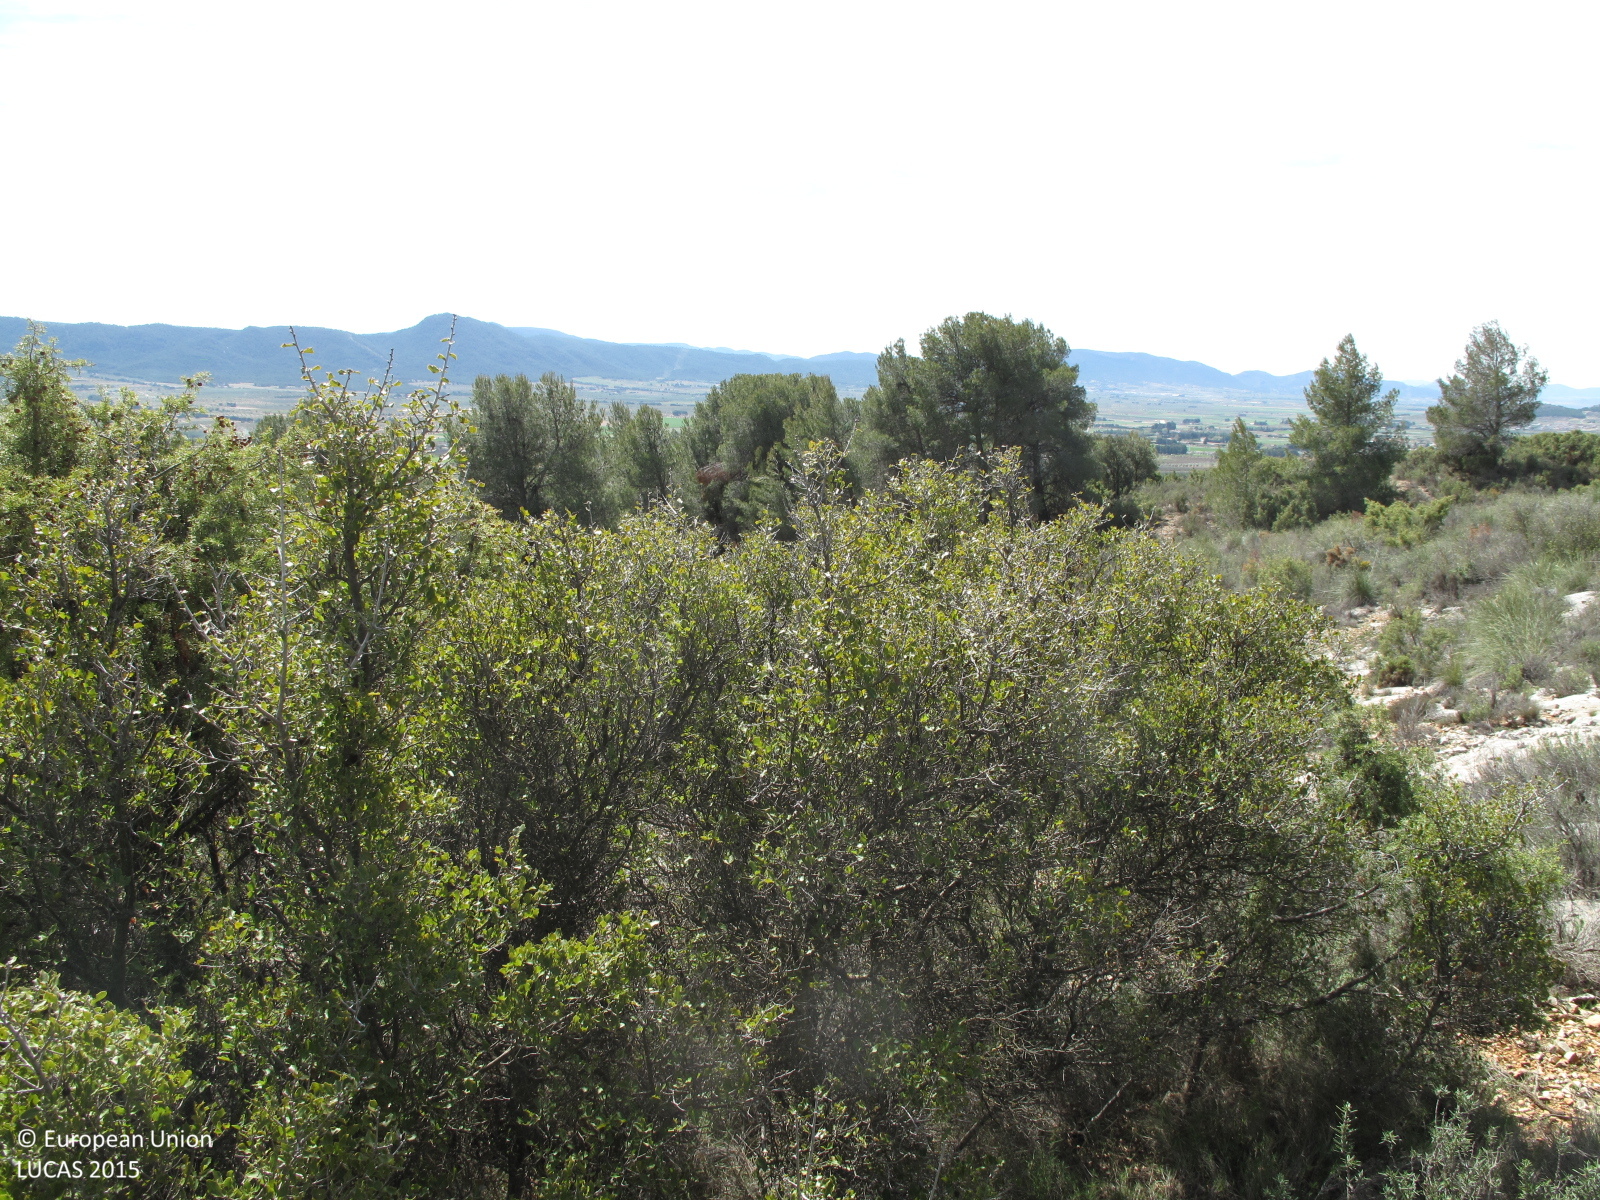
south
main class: Shrubland
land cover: Shrubland with sparse tree cover
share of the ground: 25 - 50 %
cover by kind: herbaceous plants 40 %, shrubs 30 %, consolidated bare surface 25 %, coniferous forest trees 5 %
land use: Semi-natural and natural areas not in use
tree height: > 5 m
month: March
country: ES
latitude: 38.7264
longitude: -0.7456
